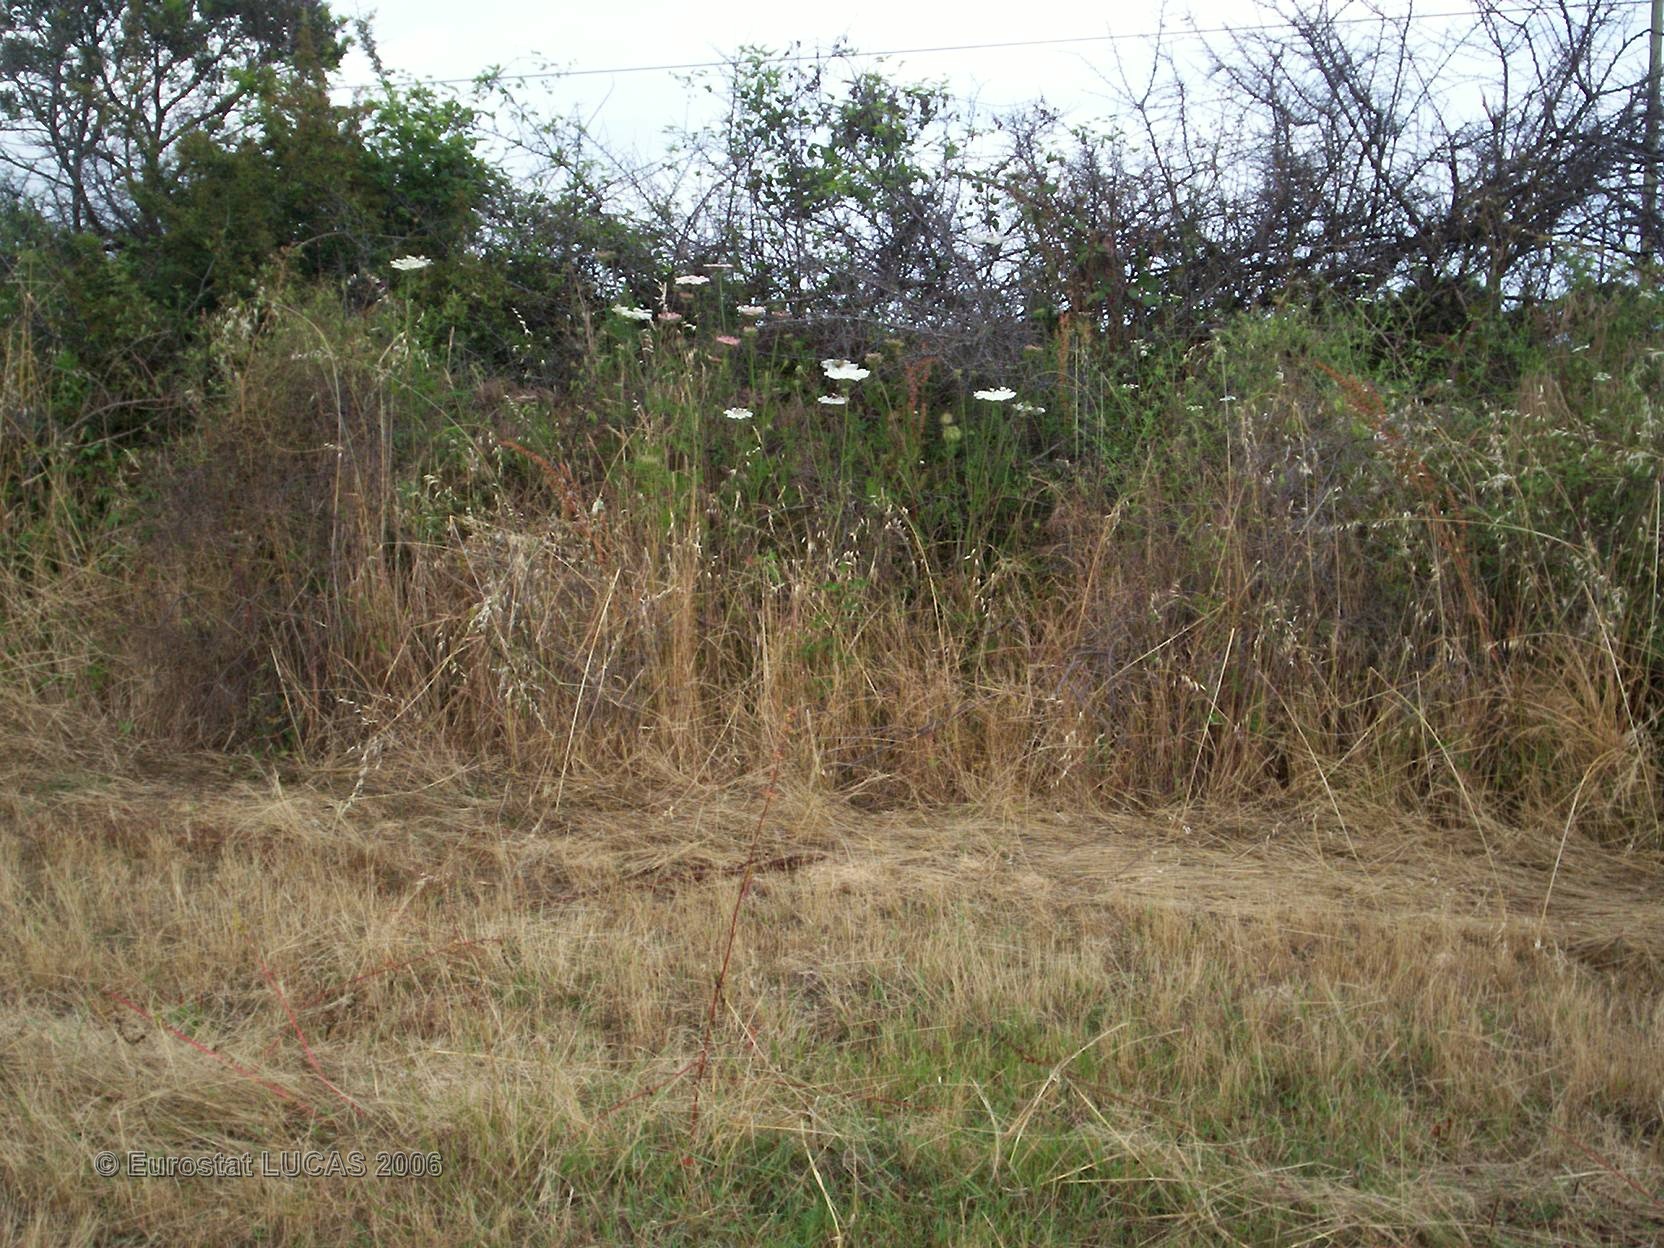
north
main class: Grassland
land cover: Grassland without tree/shrub cover
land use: Agriculture (excluding fallow land and kitchen gardens)
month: June
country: FR
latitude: 42.2556
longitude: 9.5531
